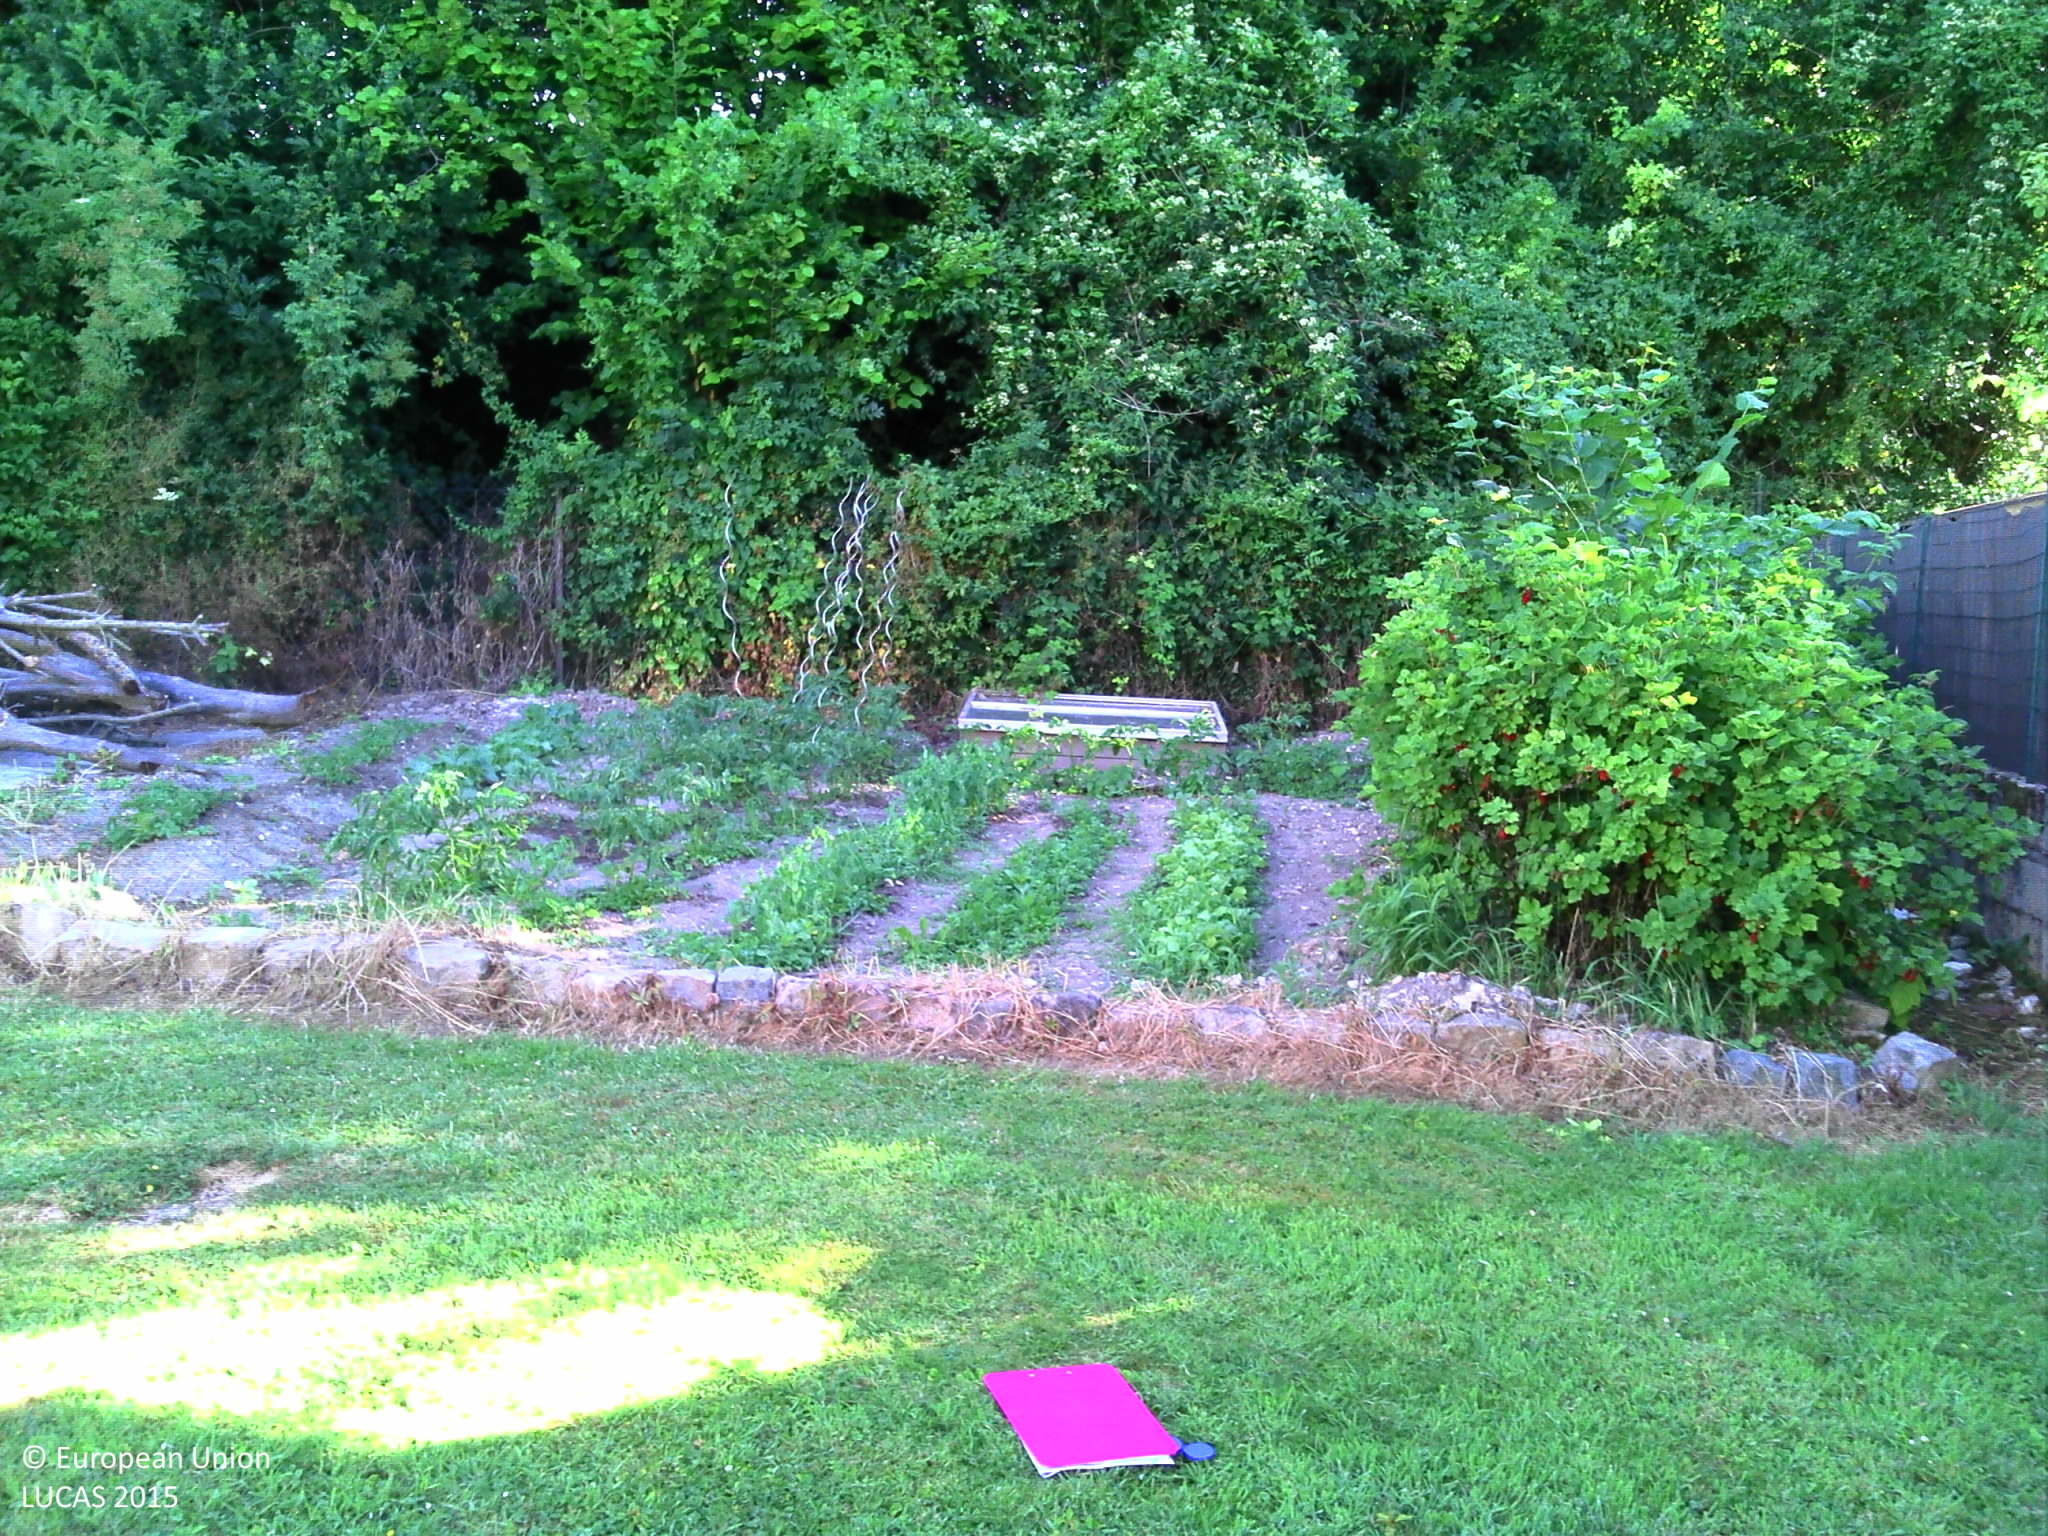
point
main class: Grassland
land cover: Grassland with sparse tree/shrub cover
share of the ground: > 75 %
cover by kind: herbaceous plants 95 %, coniferous forest trees 5 %
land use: Residential
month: June
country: FR
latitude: 49.4560
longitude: 2.3305
